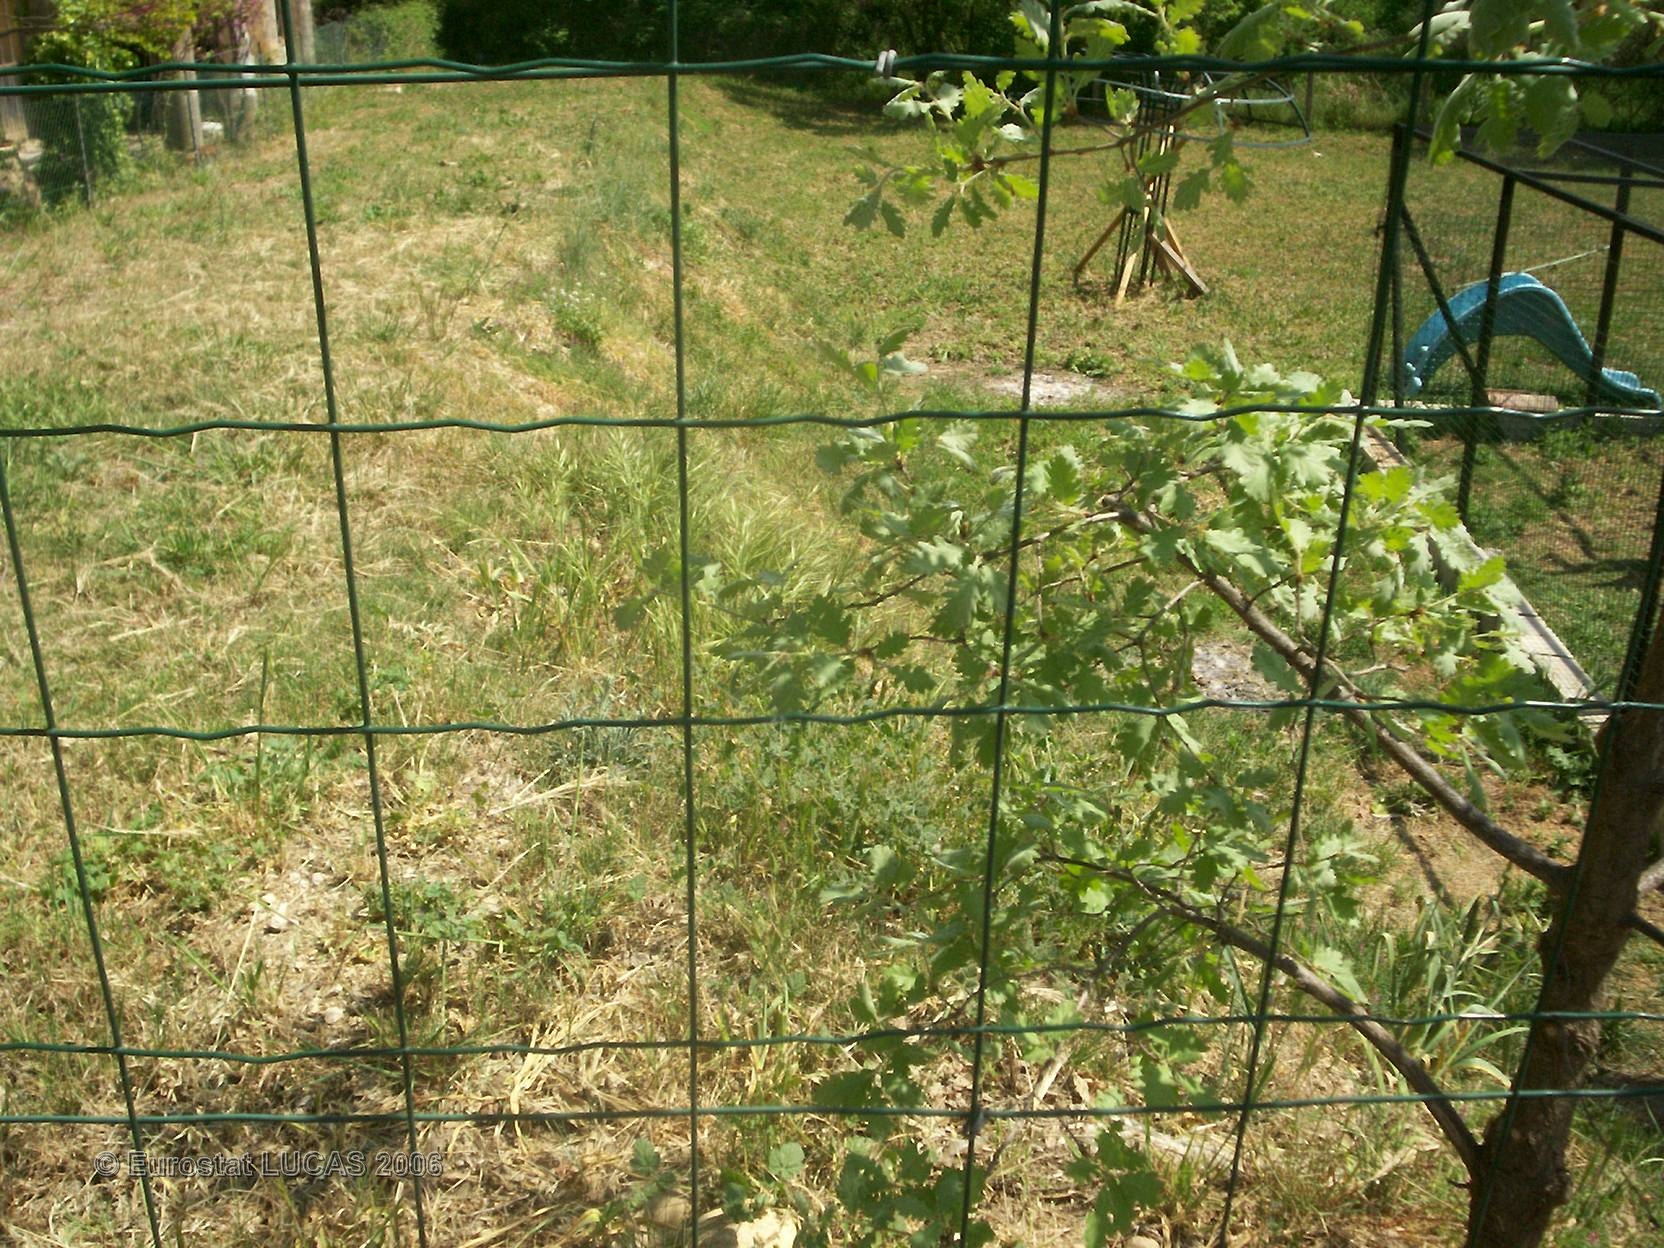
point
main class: Grassland
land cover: Grassland with sparse tree/shrub cover
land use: Residential
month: April
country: FR
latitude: 43.2980
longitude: 5.5604
